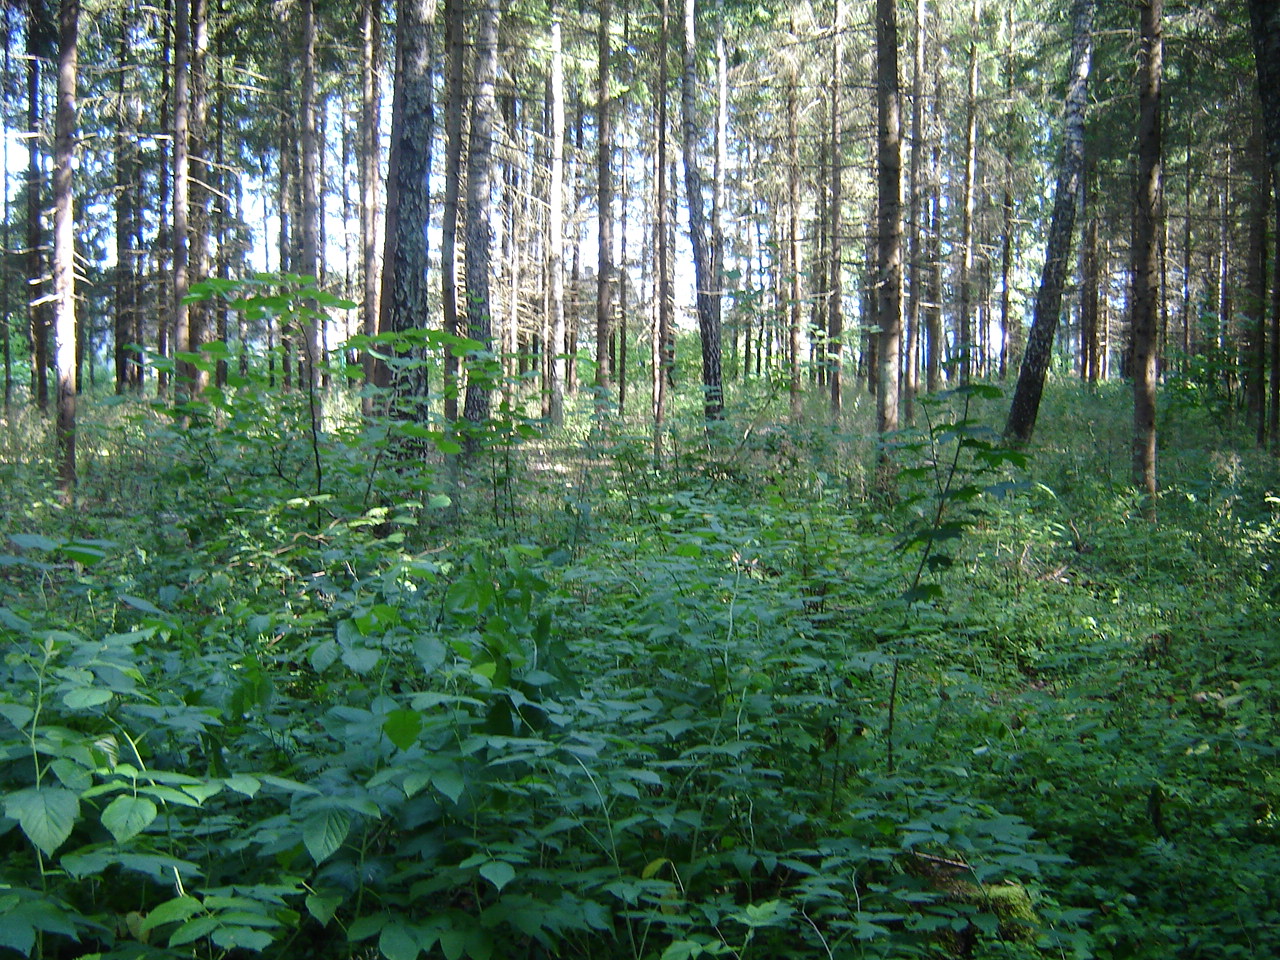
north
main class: Woodland
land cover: Spruce dominated mixed woodland
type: hemiboreal forest and nemoral coniferous forest and mixed broadleaved-coniferous forest
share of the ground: > 75 %
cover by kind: coniferous forest trees 55 %, broadleaved forest trees 25 %, herbaceous plants 10 %, shrubs 5 %, lichens and mosses 5 %
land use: Forestry
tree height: > 5 m
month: August
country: LT
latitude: 54.8188
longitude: 25.3270
